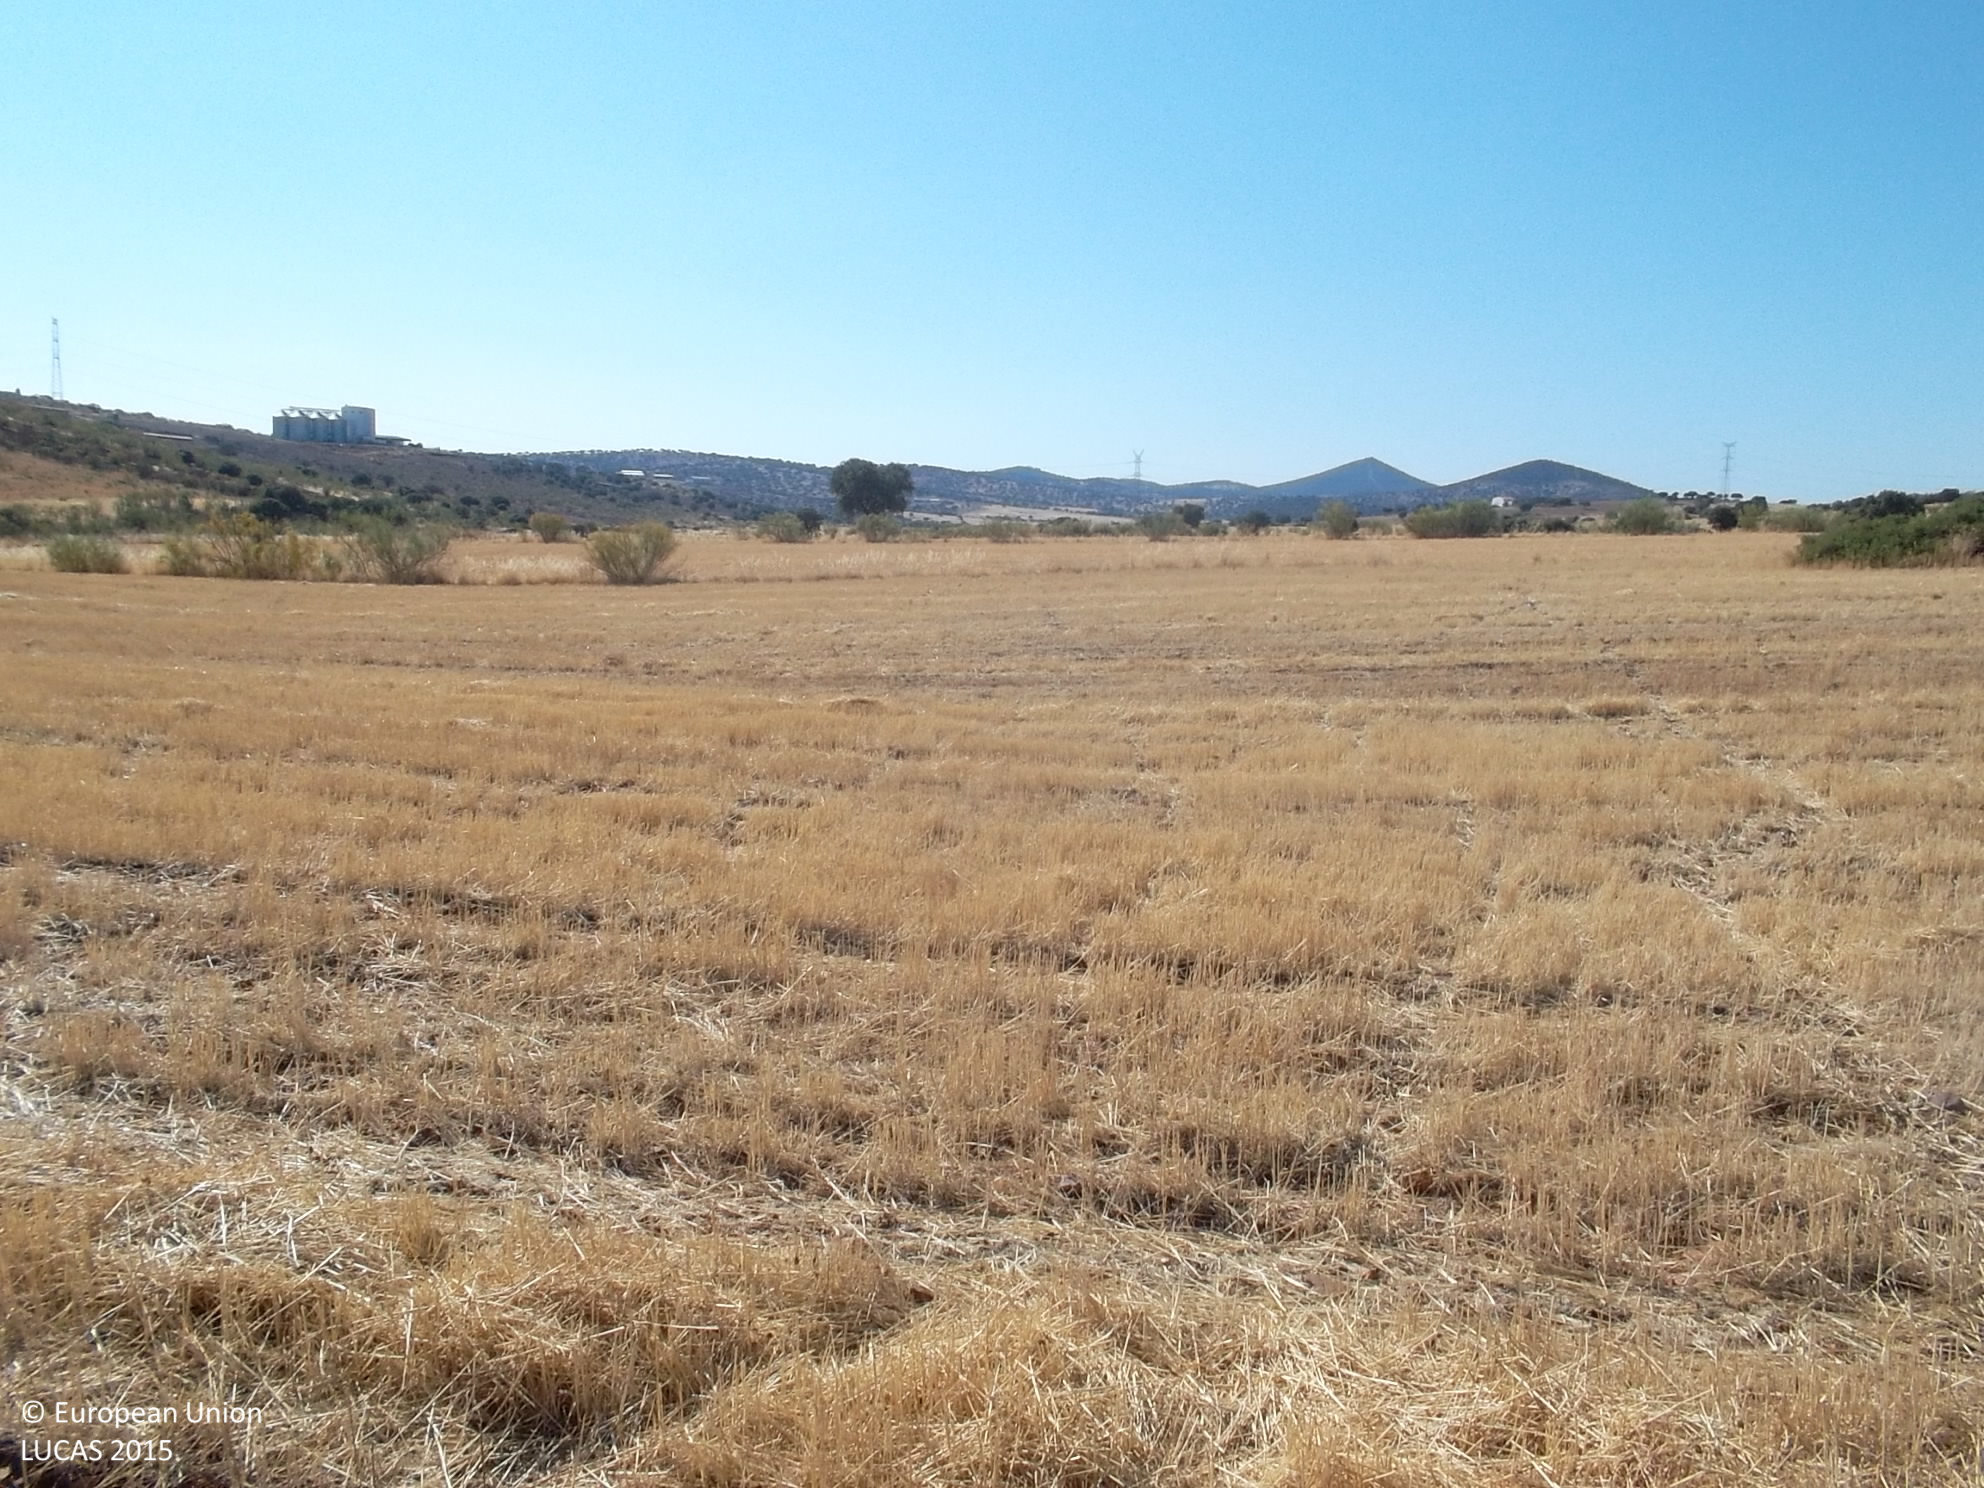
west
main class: Cropland
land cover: Durum wheat
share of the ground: < 10 %
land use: Agriculture (excluding fallow land and kitchen gardens)
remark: Harvested field
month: July
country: ES
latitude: 38.5766
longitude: -5.7785
